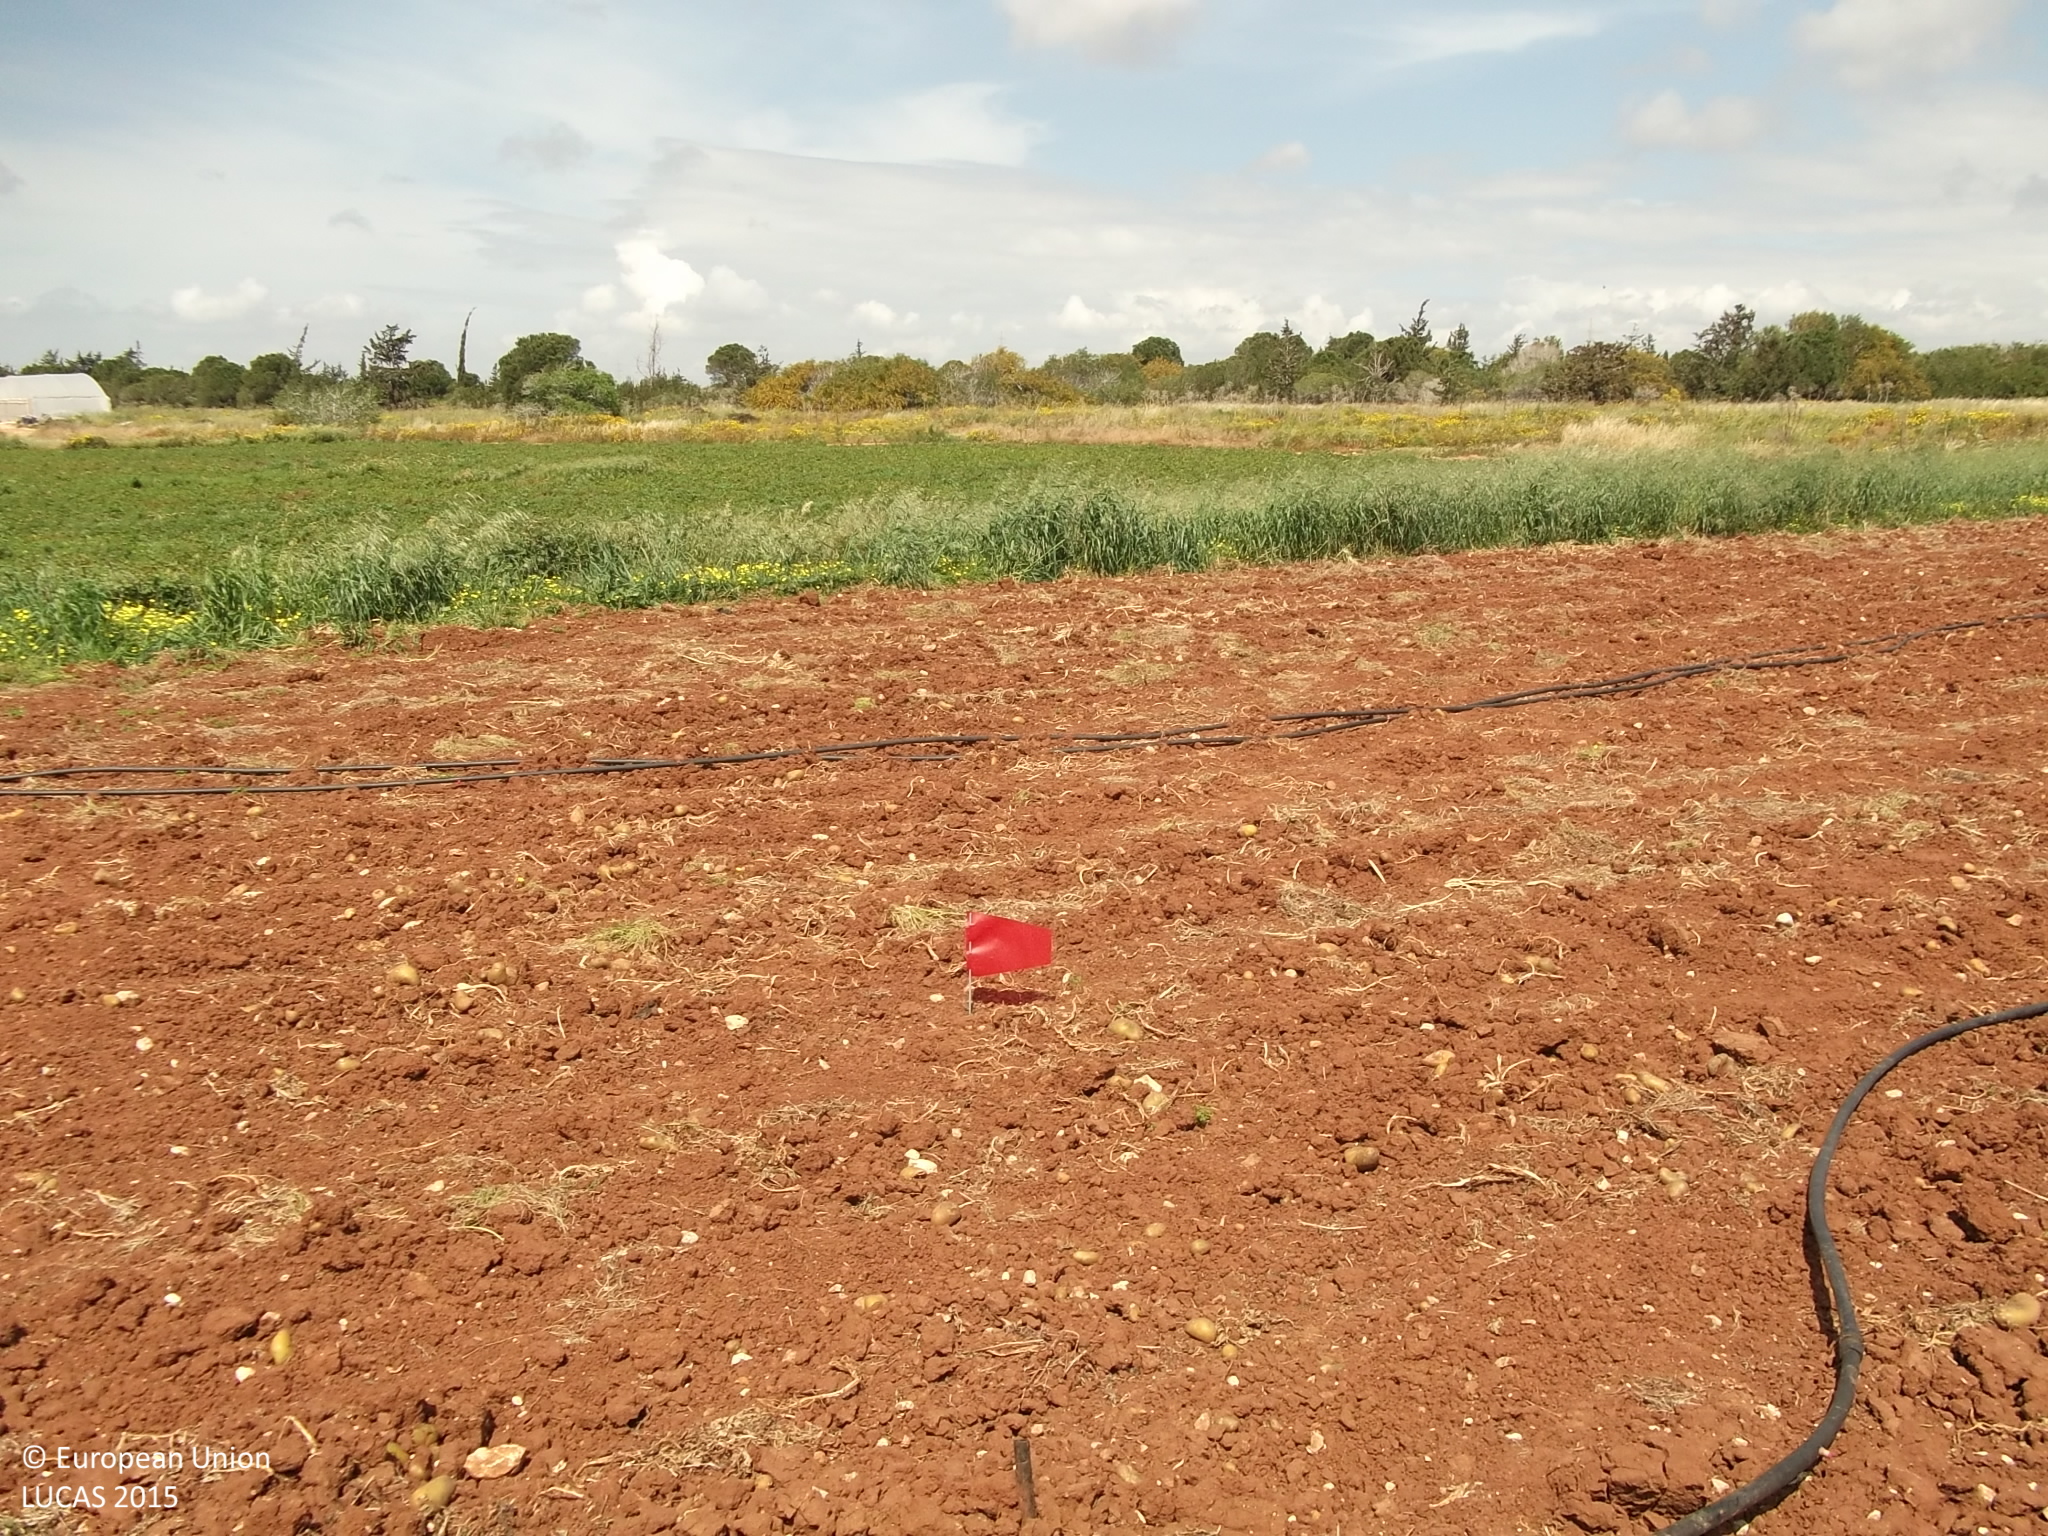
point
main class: Cropland
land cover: Potatoes
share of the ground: < 10 %
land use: Agriculture (excluding fallow land and kitchen gardens)
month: March
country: CY
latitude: 34.9953
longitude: 33.9549
